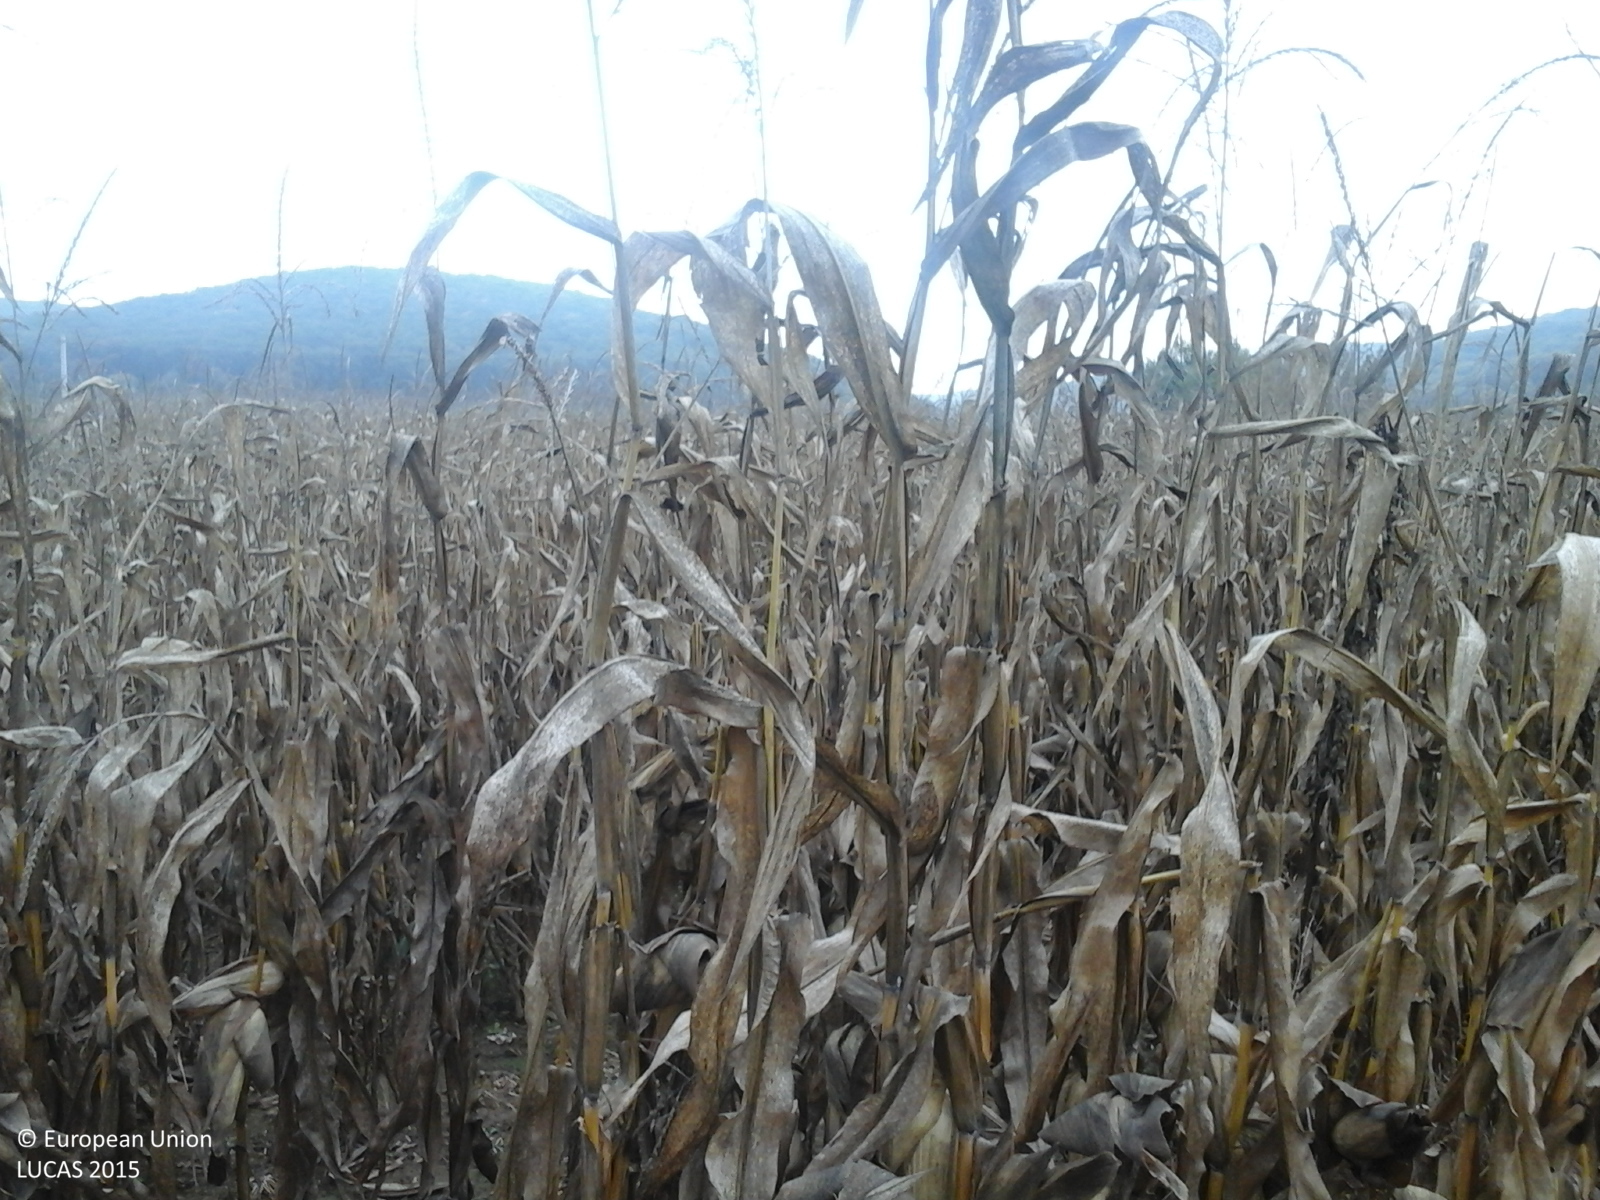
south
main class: Cropland
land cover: Maize
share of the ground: > 75 %
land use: Agriculture (excluding fallow land and kitchen gardens)
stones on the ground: < 10 %
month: October
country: RO
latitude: 46.2216
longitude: 24.7262
